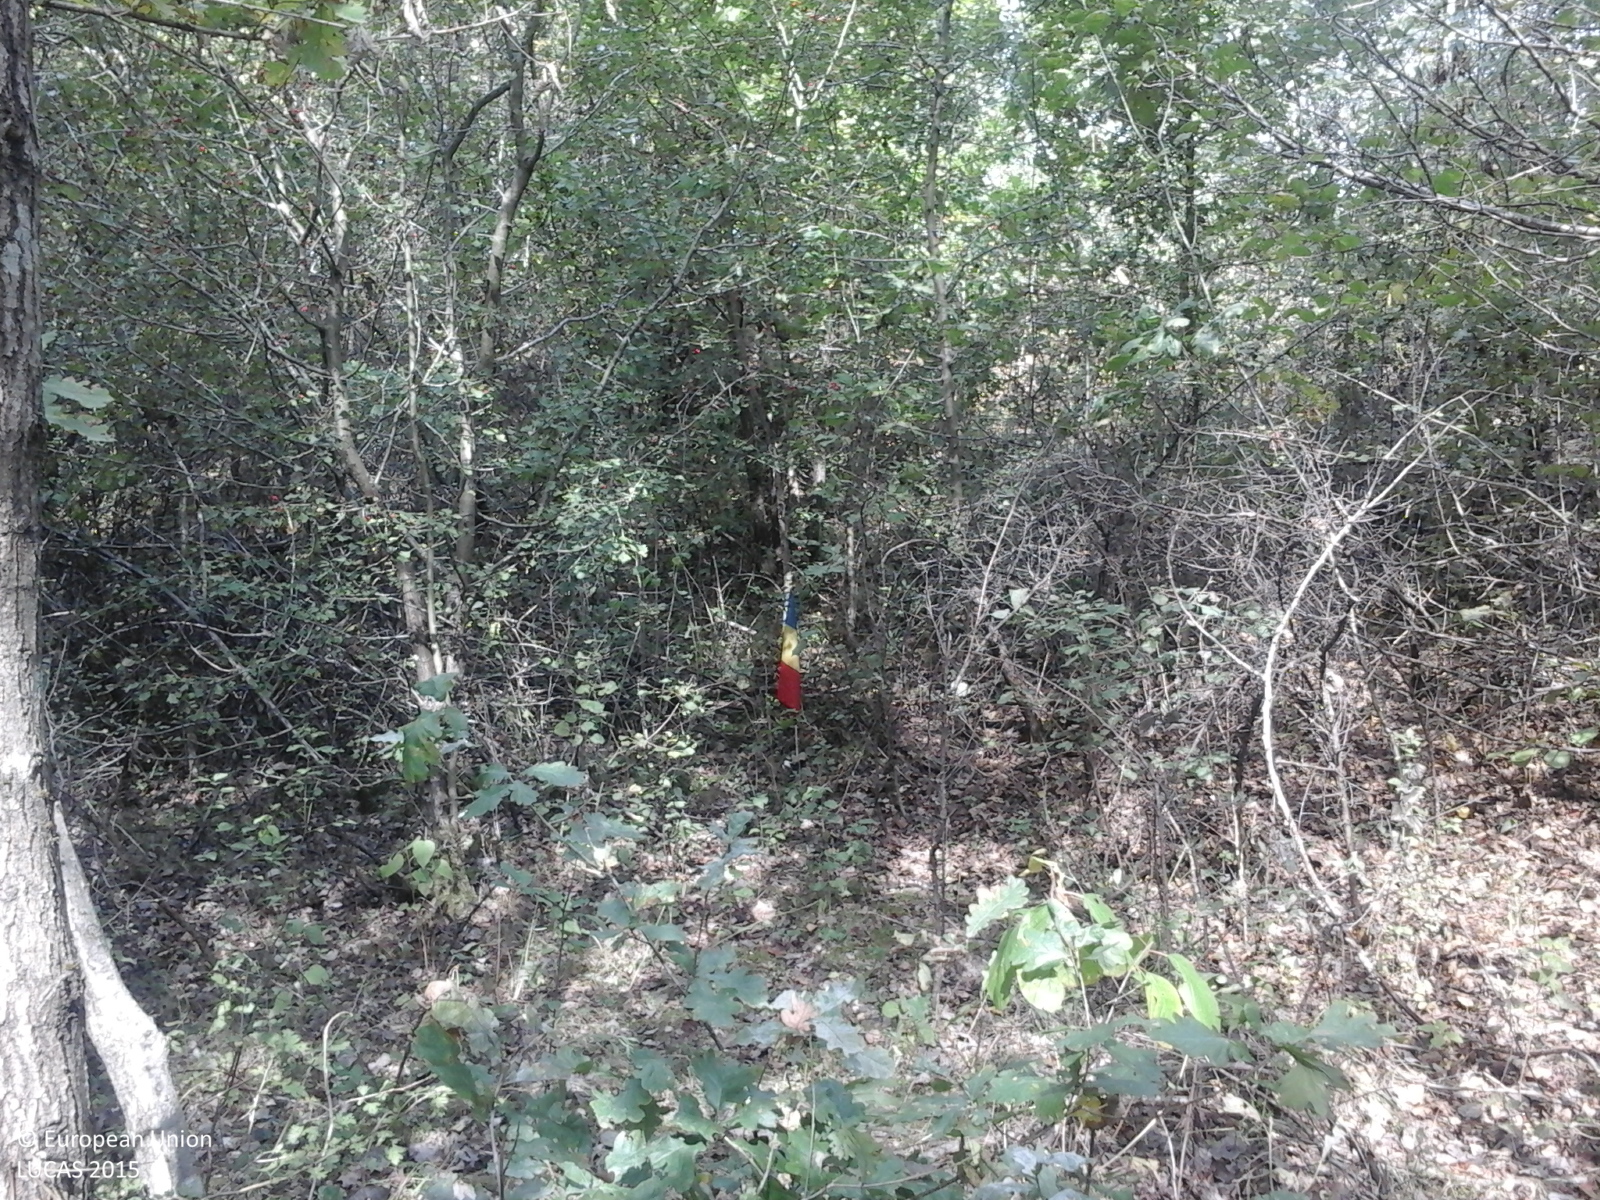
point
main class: Woodland
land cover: Broadleaved woodland
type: acidophilous oak and oak-birch forest
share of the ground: > 75 %
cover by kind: broadleaved forest trees 100 %
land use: Forestry
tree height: > 5 m
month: September
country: RO
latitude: 47.3475
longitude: 23.5356
